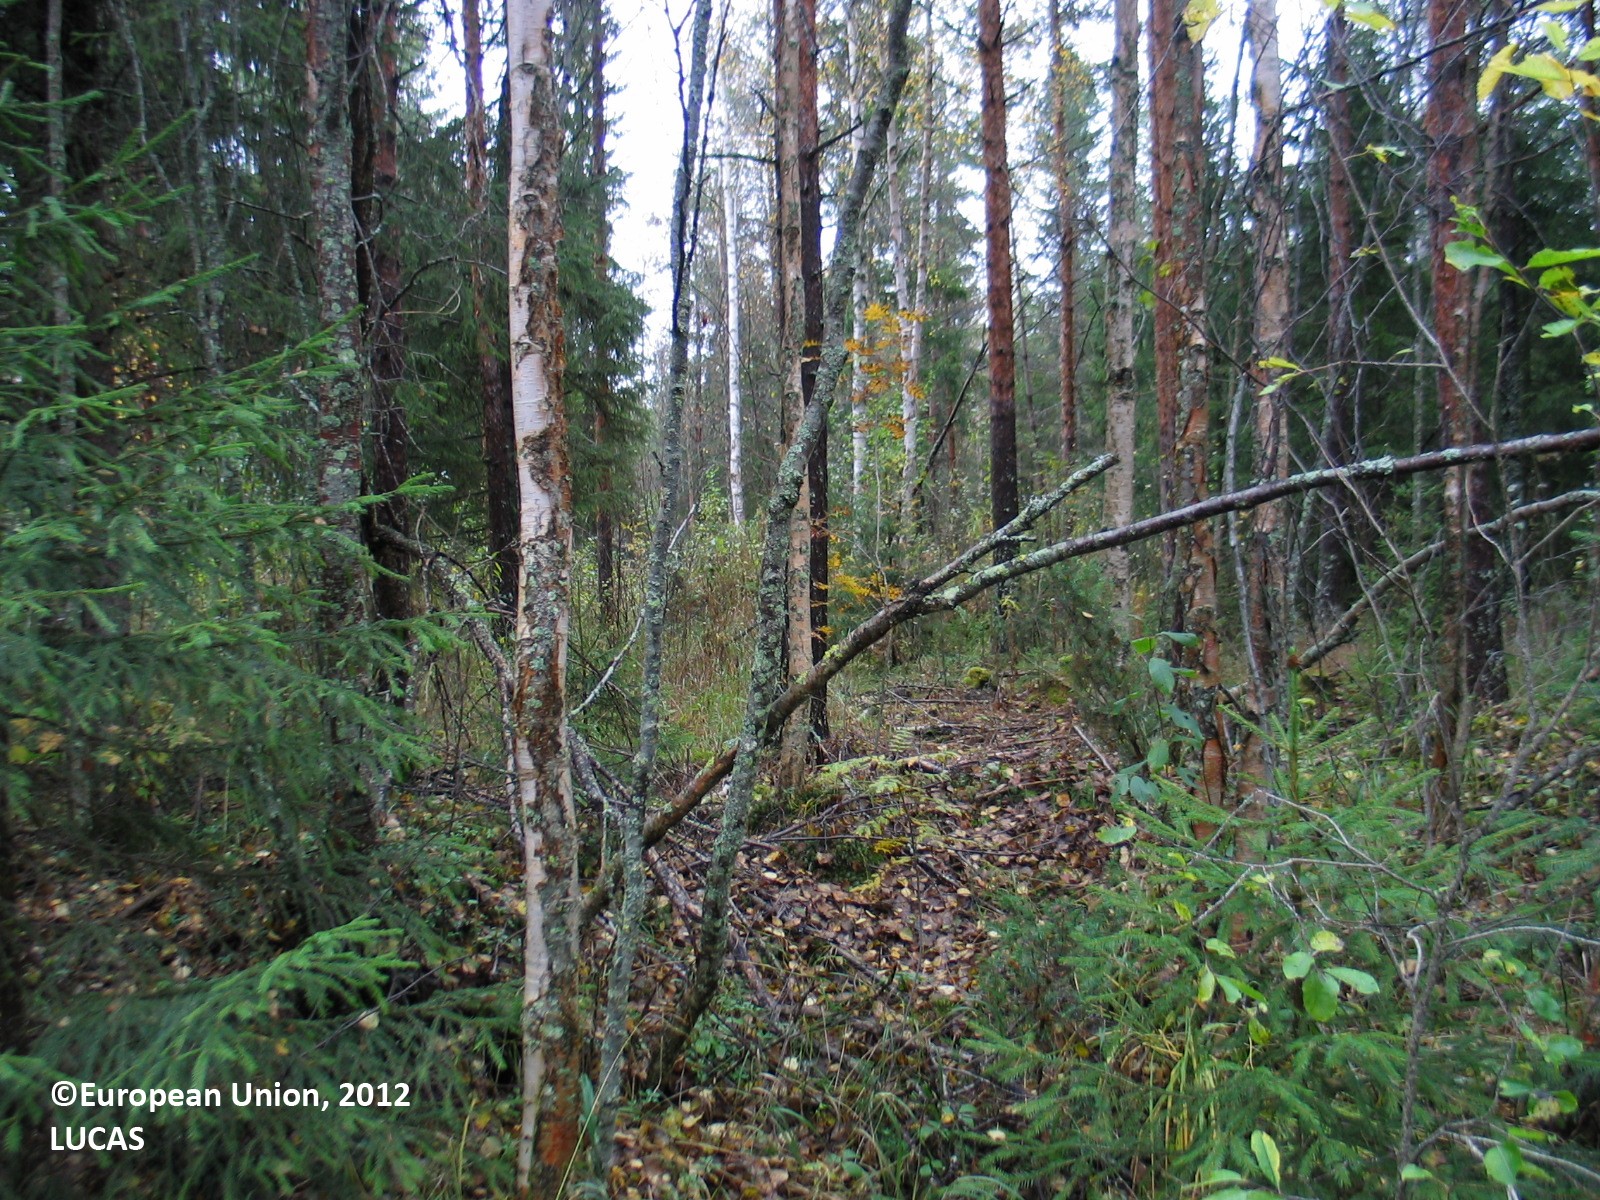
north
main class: Woodland
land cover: Other mixed woodland
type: boreal forest
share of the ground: 50 - 75 %
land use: Forestry
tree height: > 5 m
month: September
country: FI
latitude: 65.3513
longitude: 25.4868
